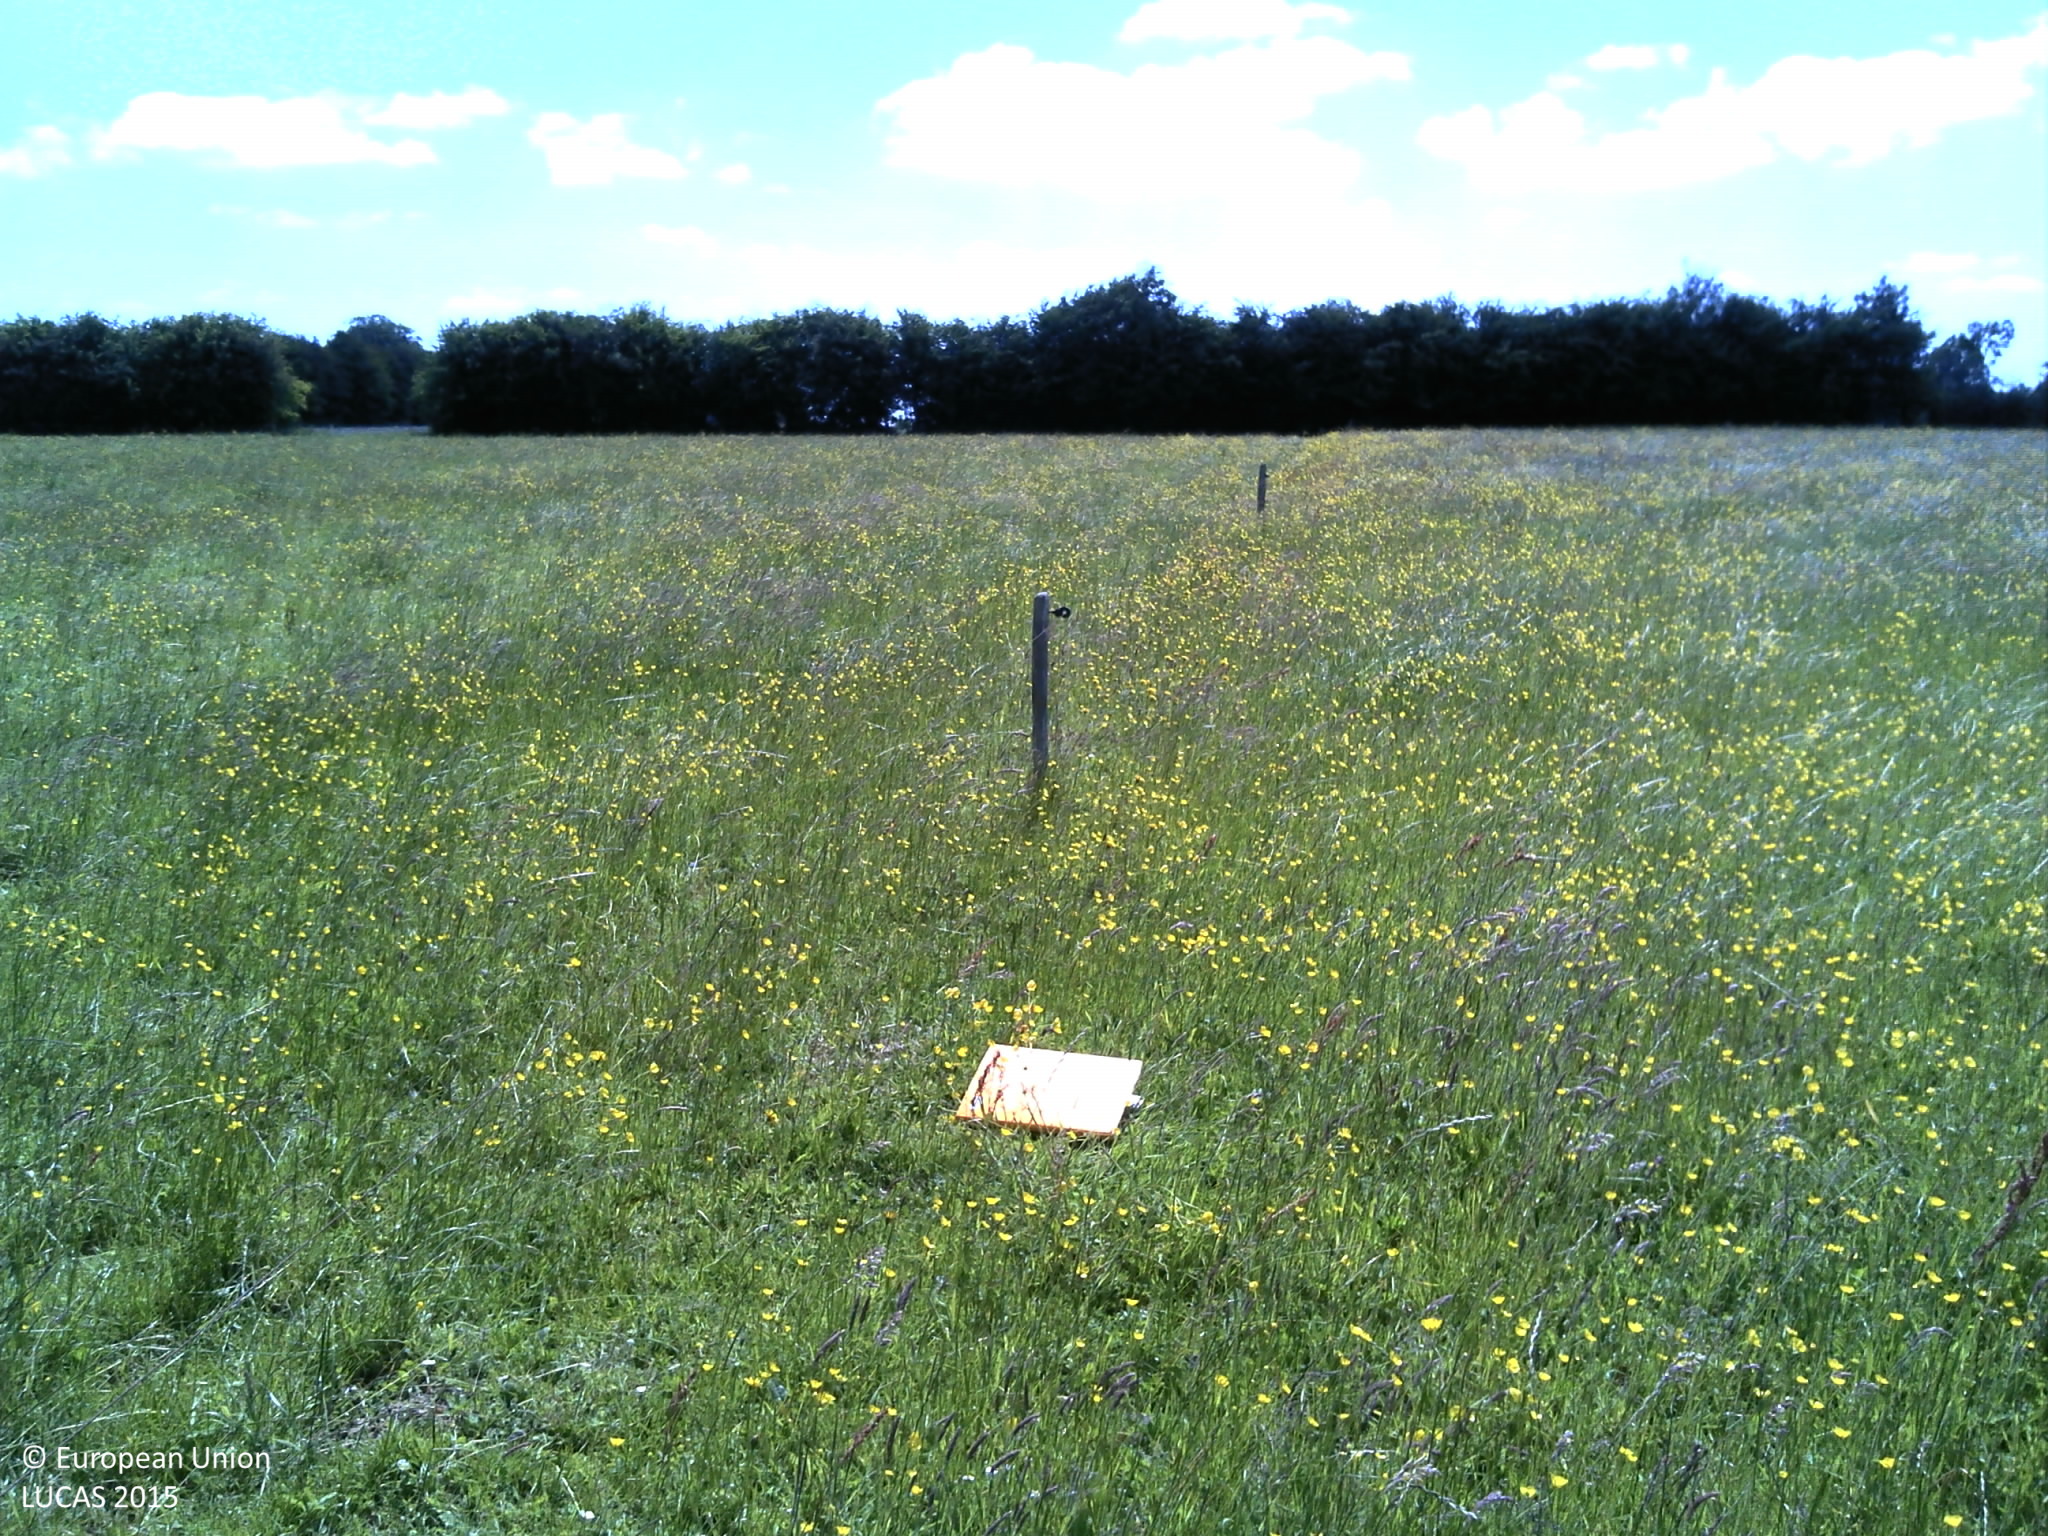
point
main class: Grassland
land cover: Grassland without tree/shrub cover
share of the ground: > 75 %
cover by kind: herbaceous plants 100 %
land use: Agriculture (excluding fallow land and kitchen gardens)
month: June
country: FR
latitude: 49.5298
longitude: 1.1223
